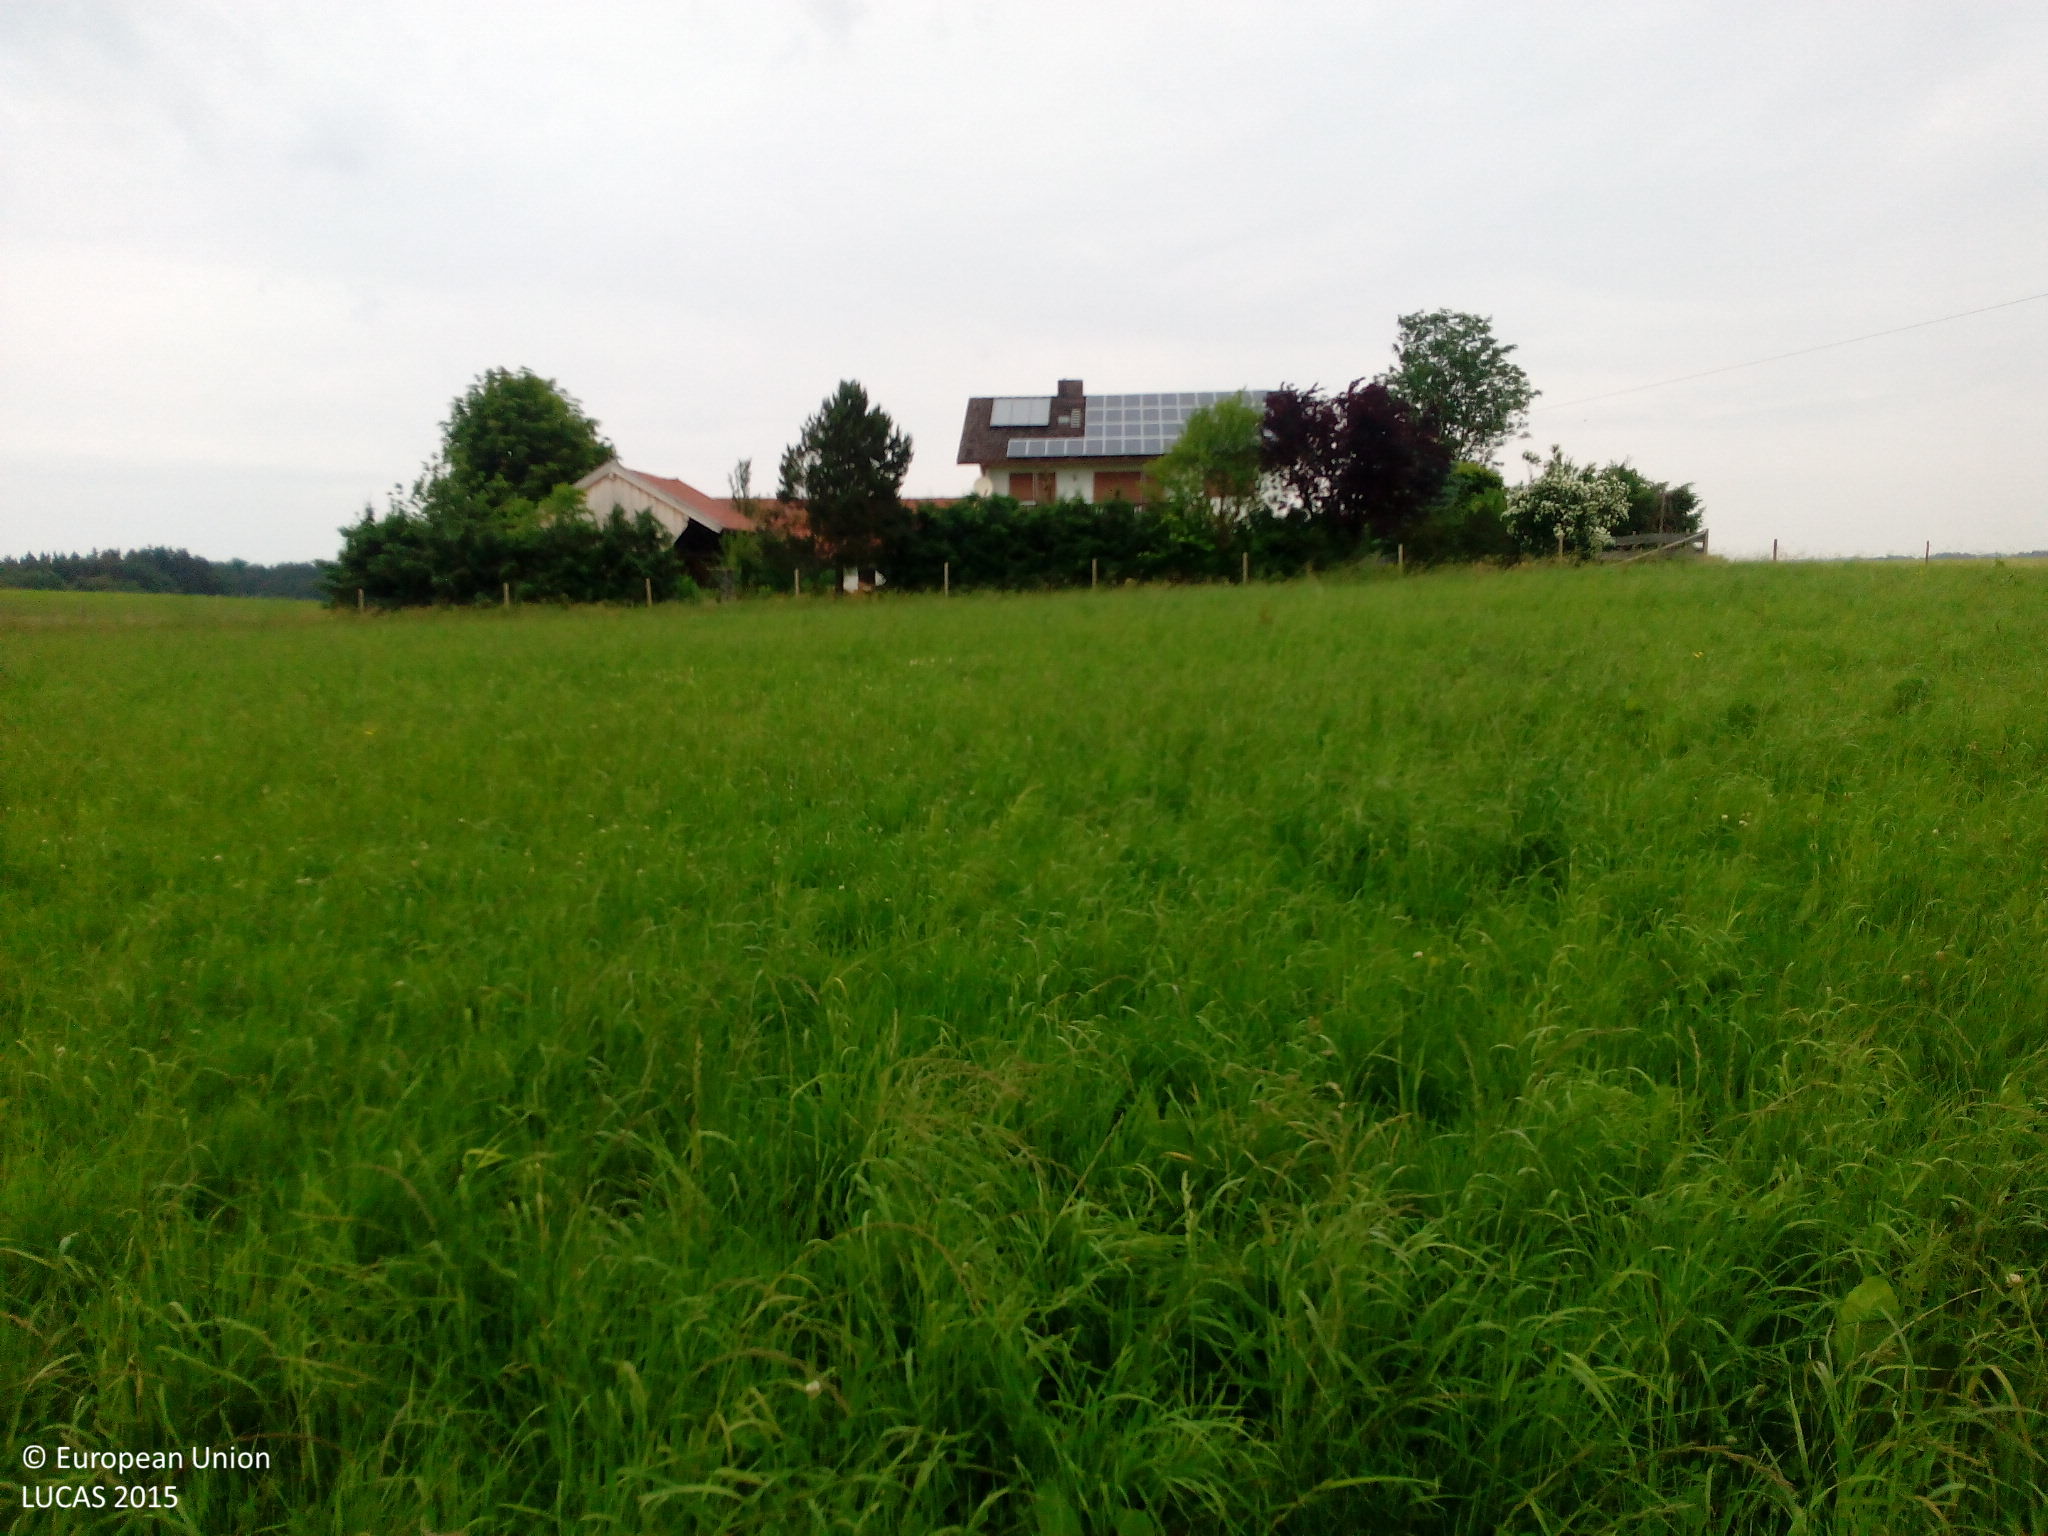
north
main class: Grassland
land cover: Grassland without tree/shrub cover
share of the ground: > 75 %
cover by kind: herbaceous plants 100 %
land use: Agriculture (excluding fallow land and kitchen gardens)
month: June
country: DE
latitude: 47.9090
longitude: 11.3771
